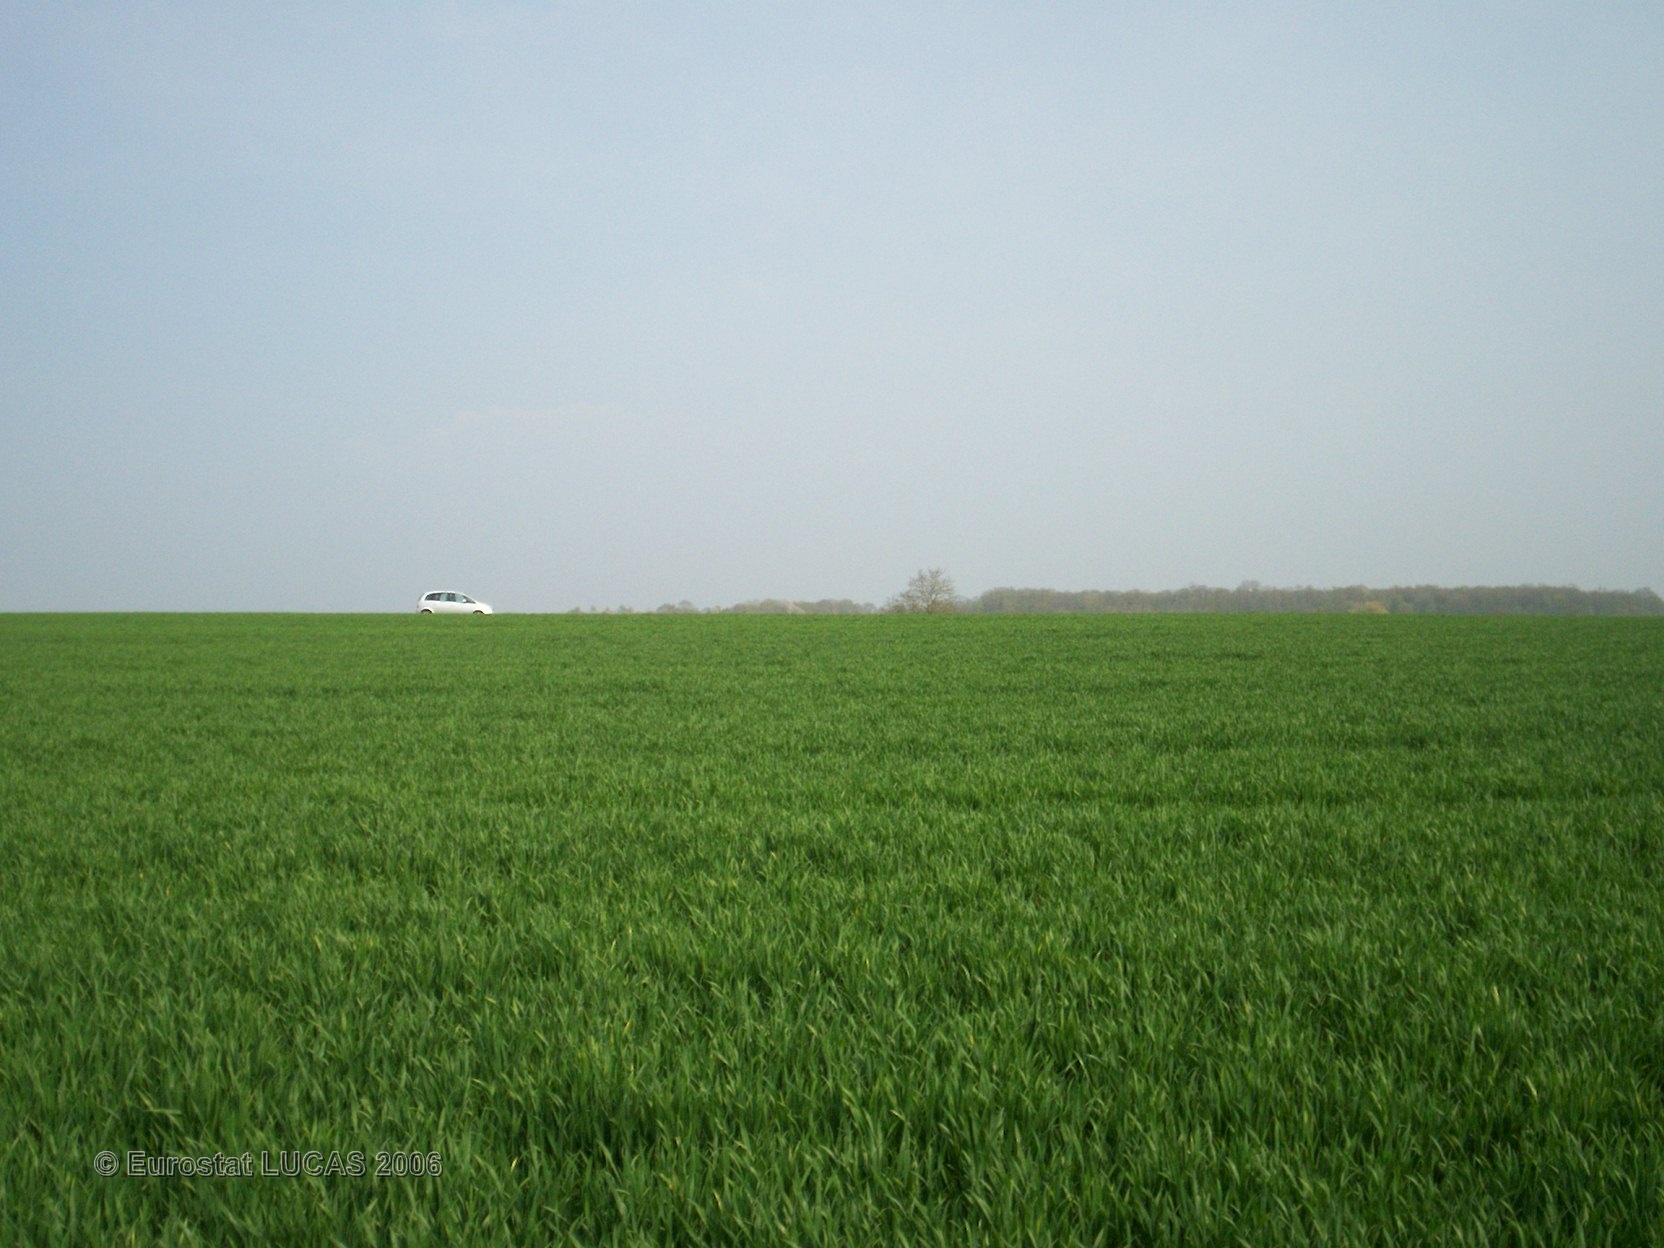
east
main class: Cropland
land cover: Common wheat
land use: Agriculture (excluding fallow land and kitchen gardens)
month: April
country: FR
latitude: 49.5499
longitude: 4.5643
